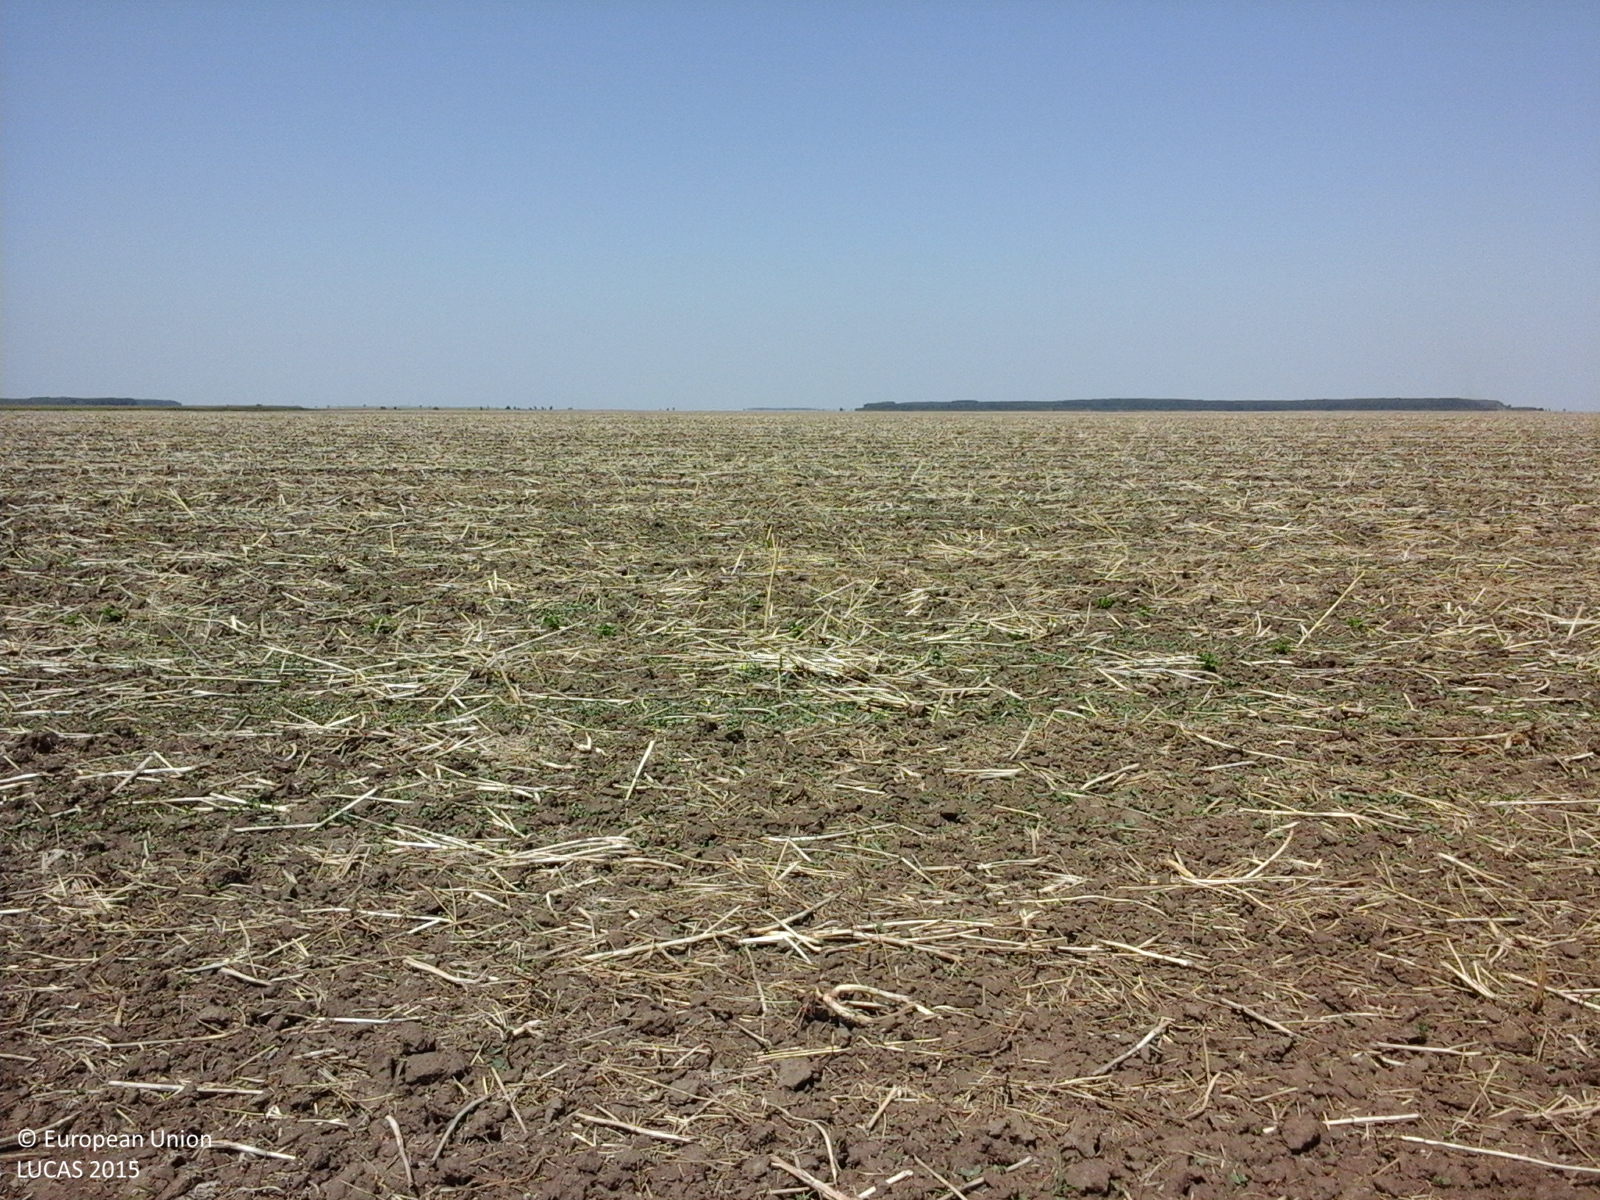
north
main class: Cropland
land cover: Rape and turnip rape
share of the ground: < 10 %
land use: Agriculture (excluding fallow land and kitchen gardens)
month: July
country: RO
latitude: 44.3072
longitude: 26.6007
